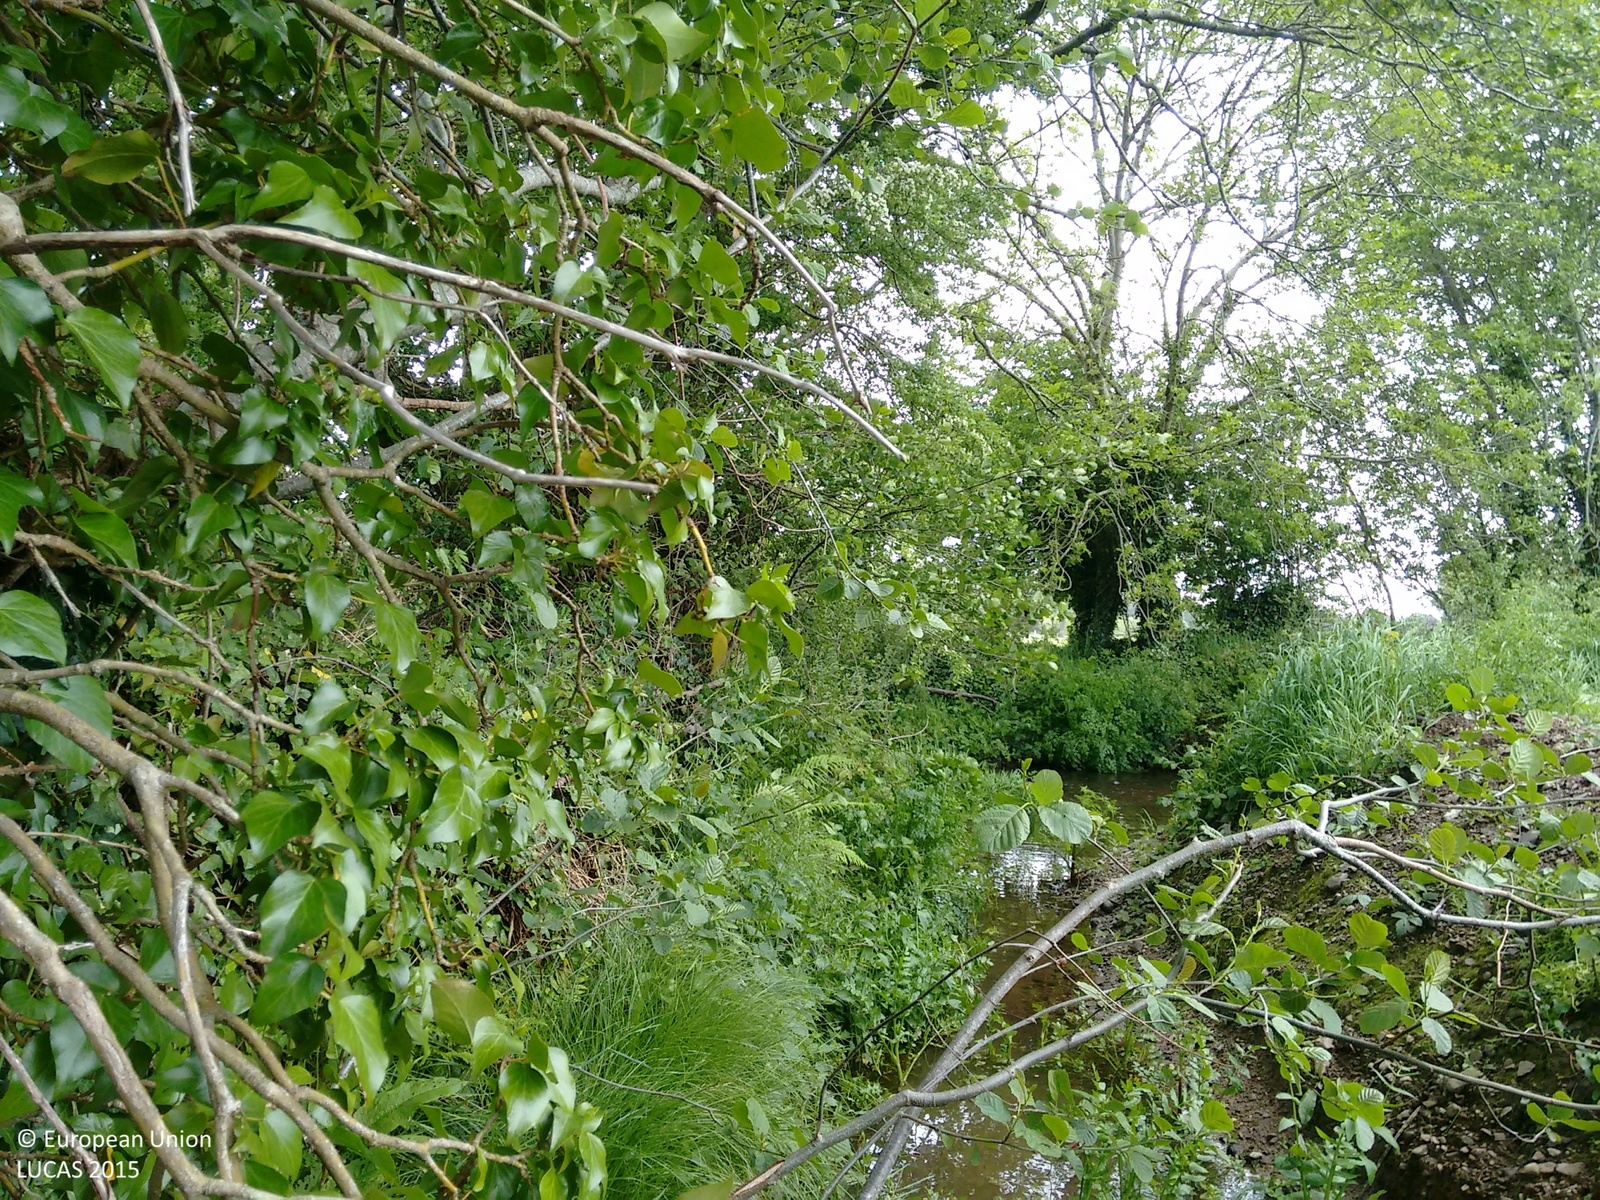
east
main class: Woodland
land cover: Broadleaved woodland
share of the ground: > 75 %
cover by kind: herbaceous plants 55 %, broadleaved forest trees 35 %
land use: Agriculture (excluding fallow land and kitchen gardens)
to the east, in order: Broadleaved woodland; Ditches and canals; Grassland without tree/shrub cover; Shruby margins; Inland fresh running water; Lines of trees; Fences; Grassland without tree/shrub cover; Fences; Lines of trees; Inland fresh running water; Shruby margins; Maize; Inland fresh running water
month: June
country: IE
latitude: 51.8483
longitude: -8.8313
